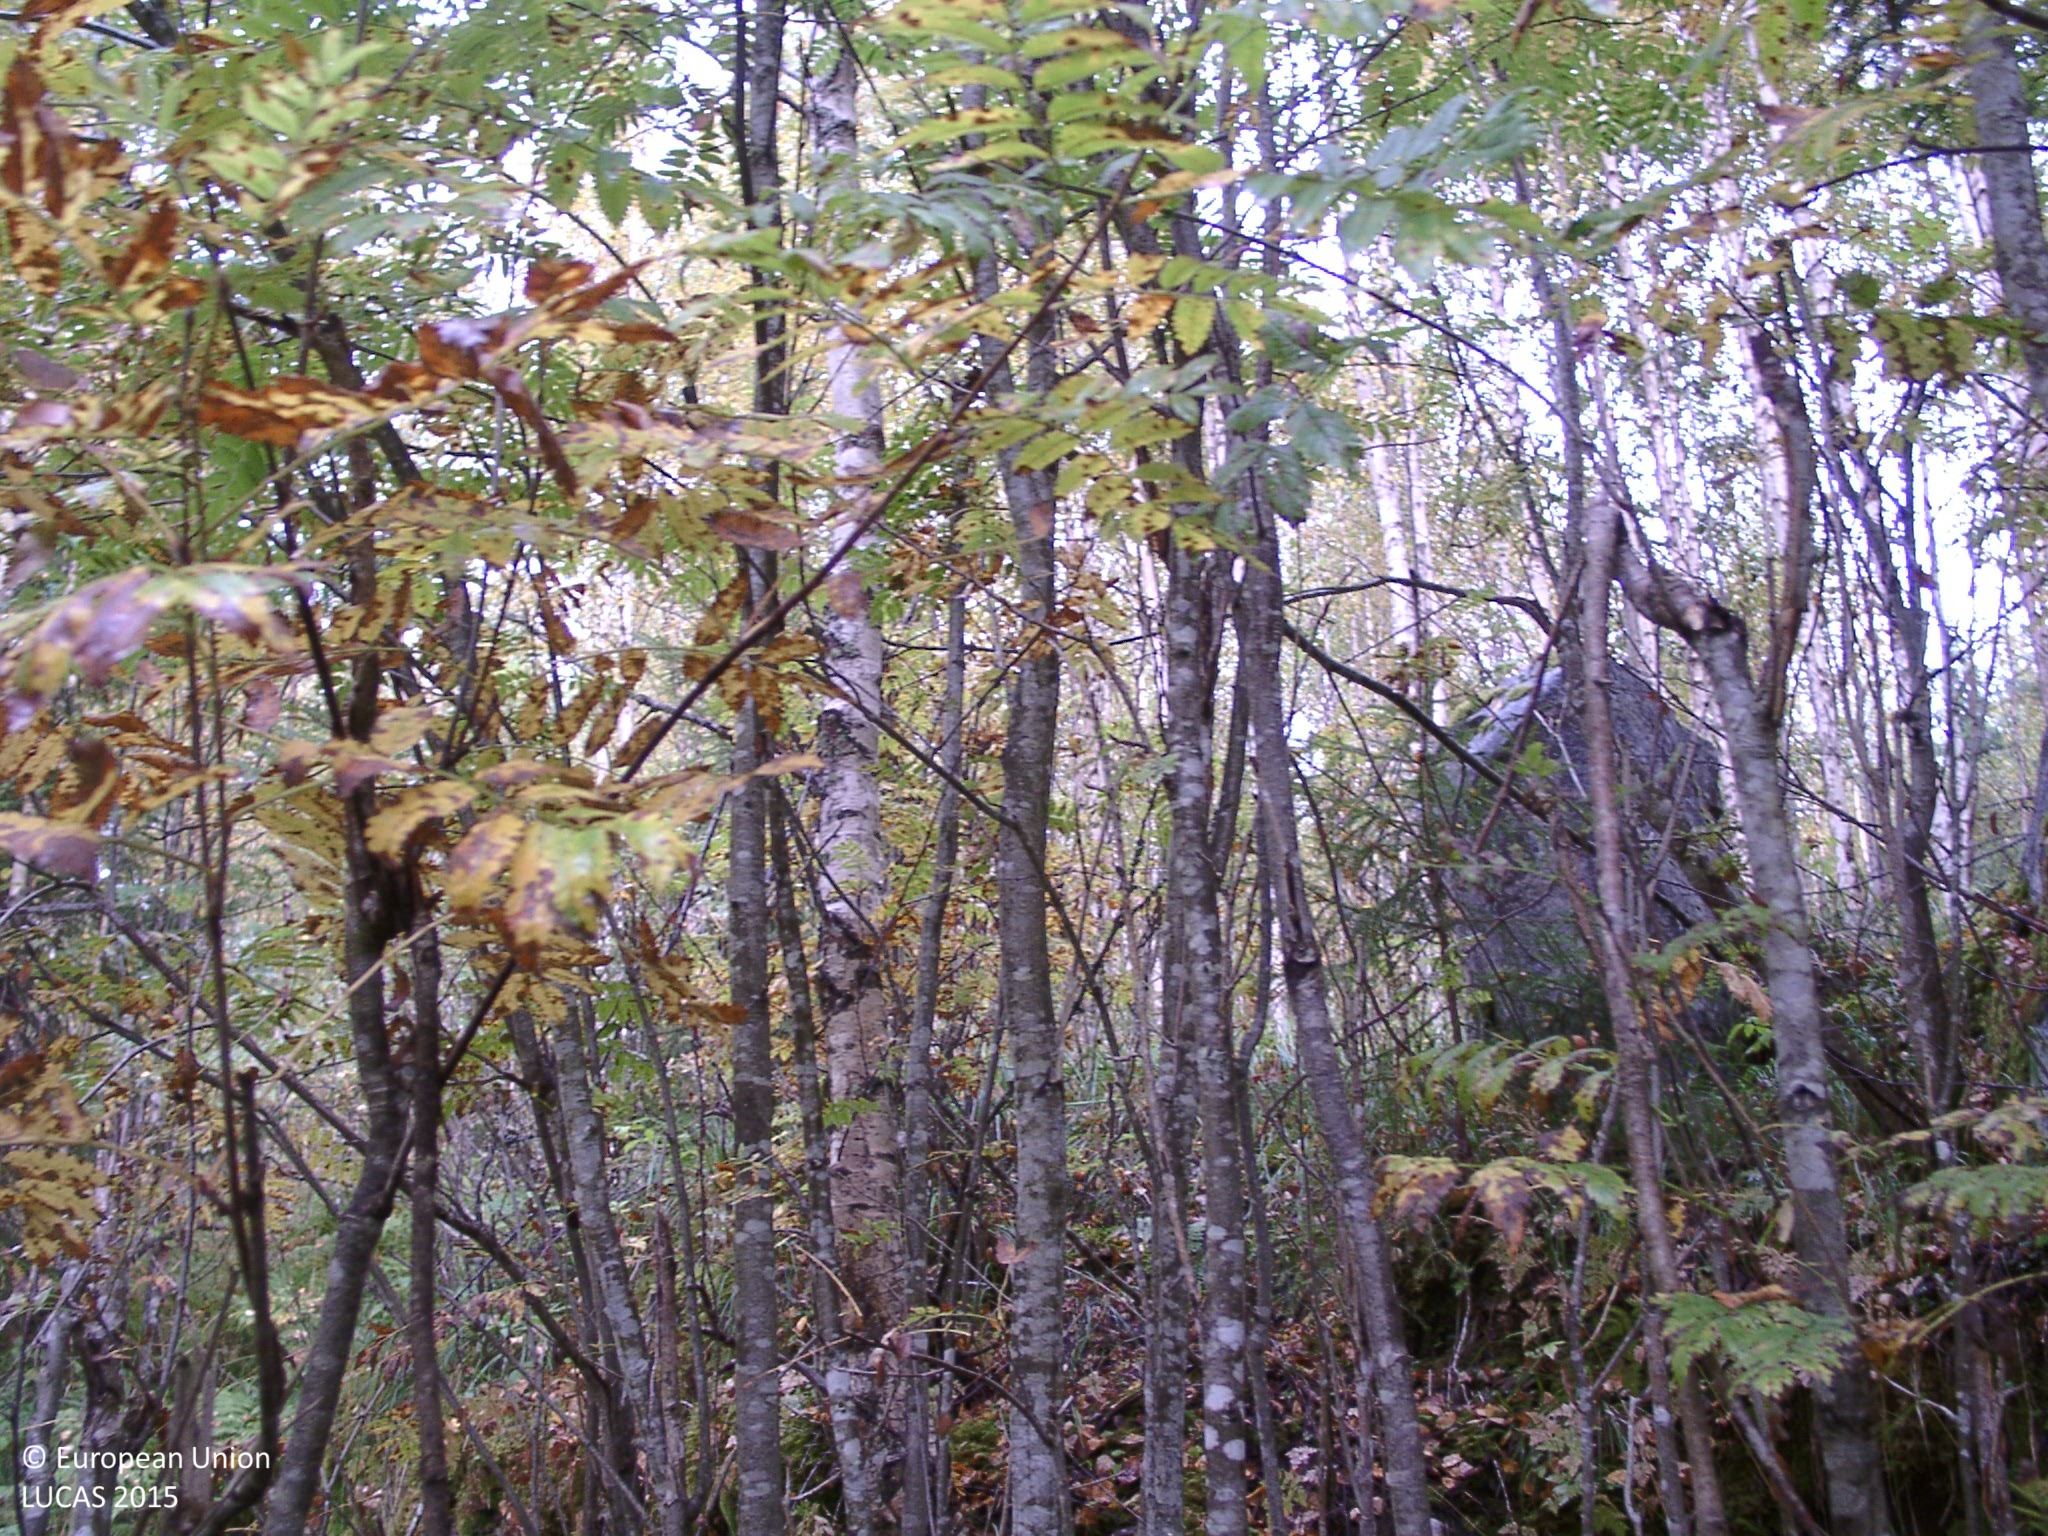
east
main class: Woodland
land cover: Broadleaved woodland
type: boreal forest
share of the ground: 50 - 75 %
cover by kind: broadleaved forest trees 65 %, herbaceous plants 20 %, coniferous forest trees 5 %, shrubs 5 %, lichens and mosses 5 %
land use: Forestry
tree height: > 5 m
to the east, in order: Broadleaved woodland; Spruce dominated mixed woodland; Ditches and canals; Spruce dominated mixed woodland
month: September
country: FI
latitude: 62.4827
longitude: 25.6959
